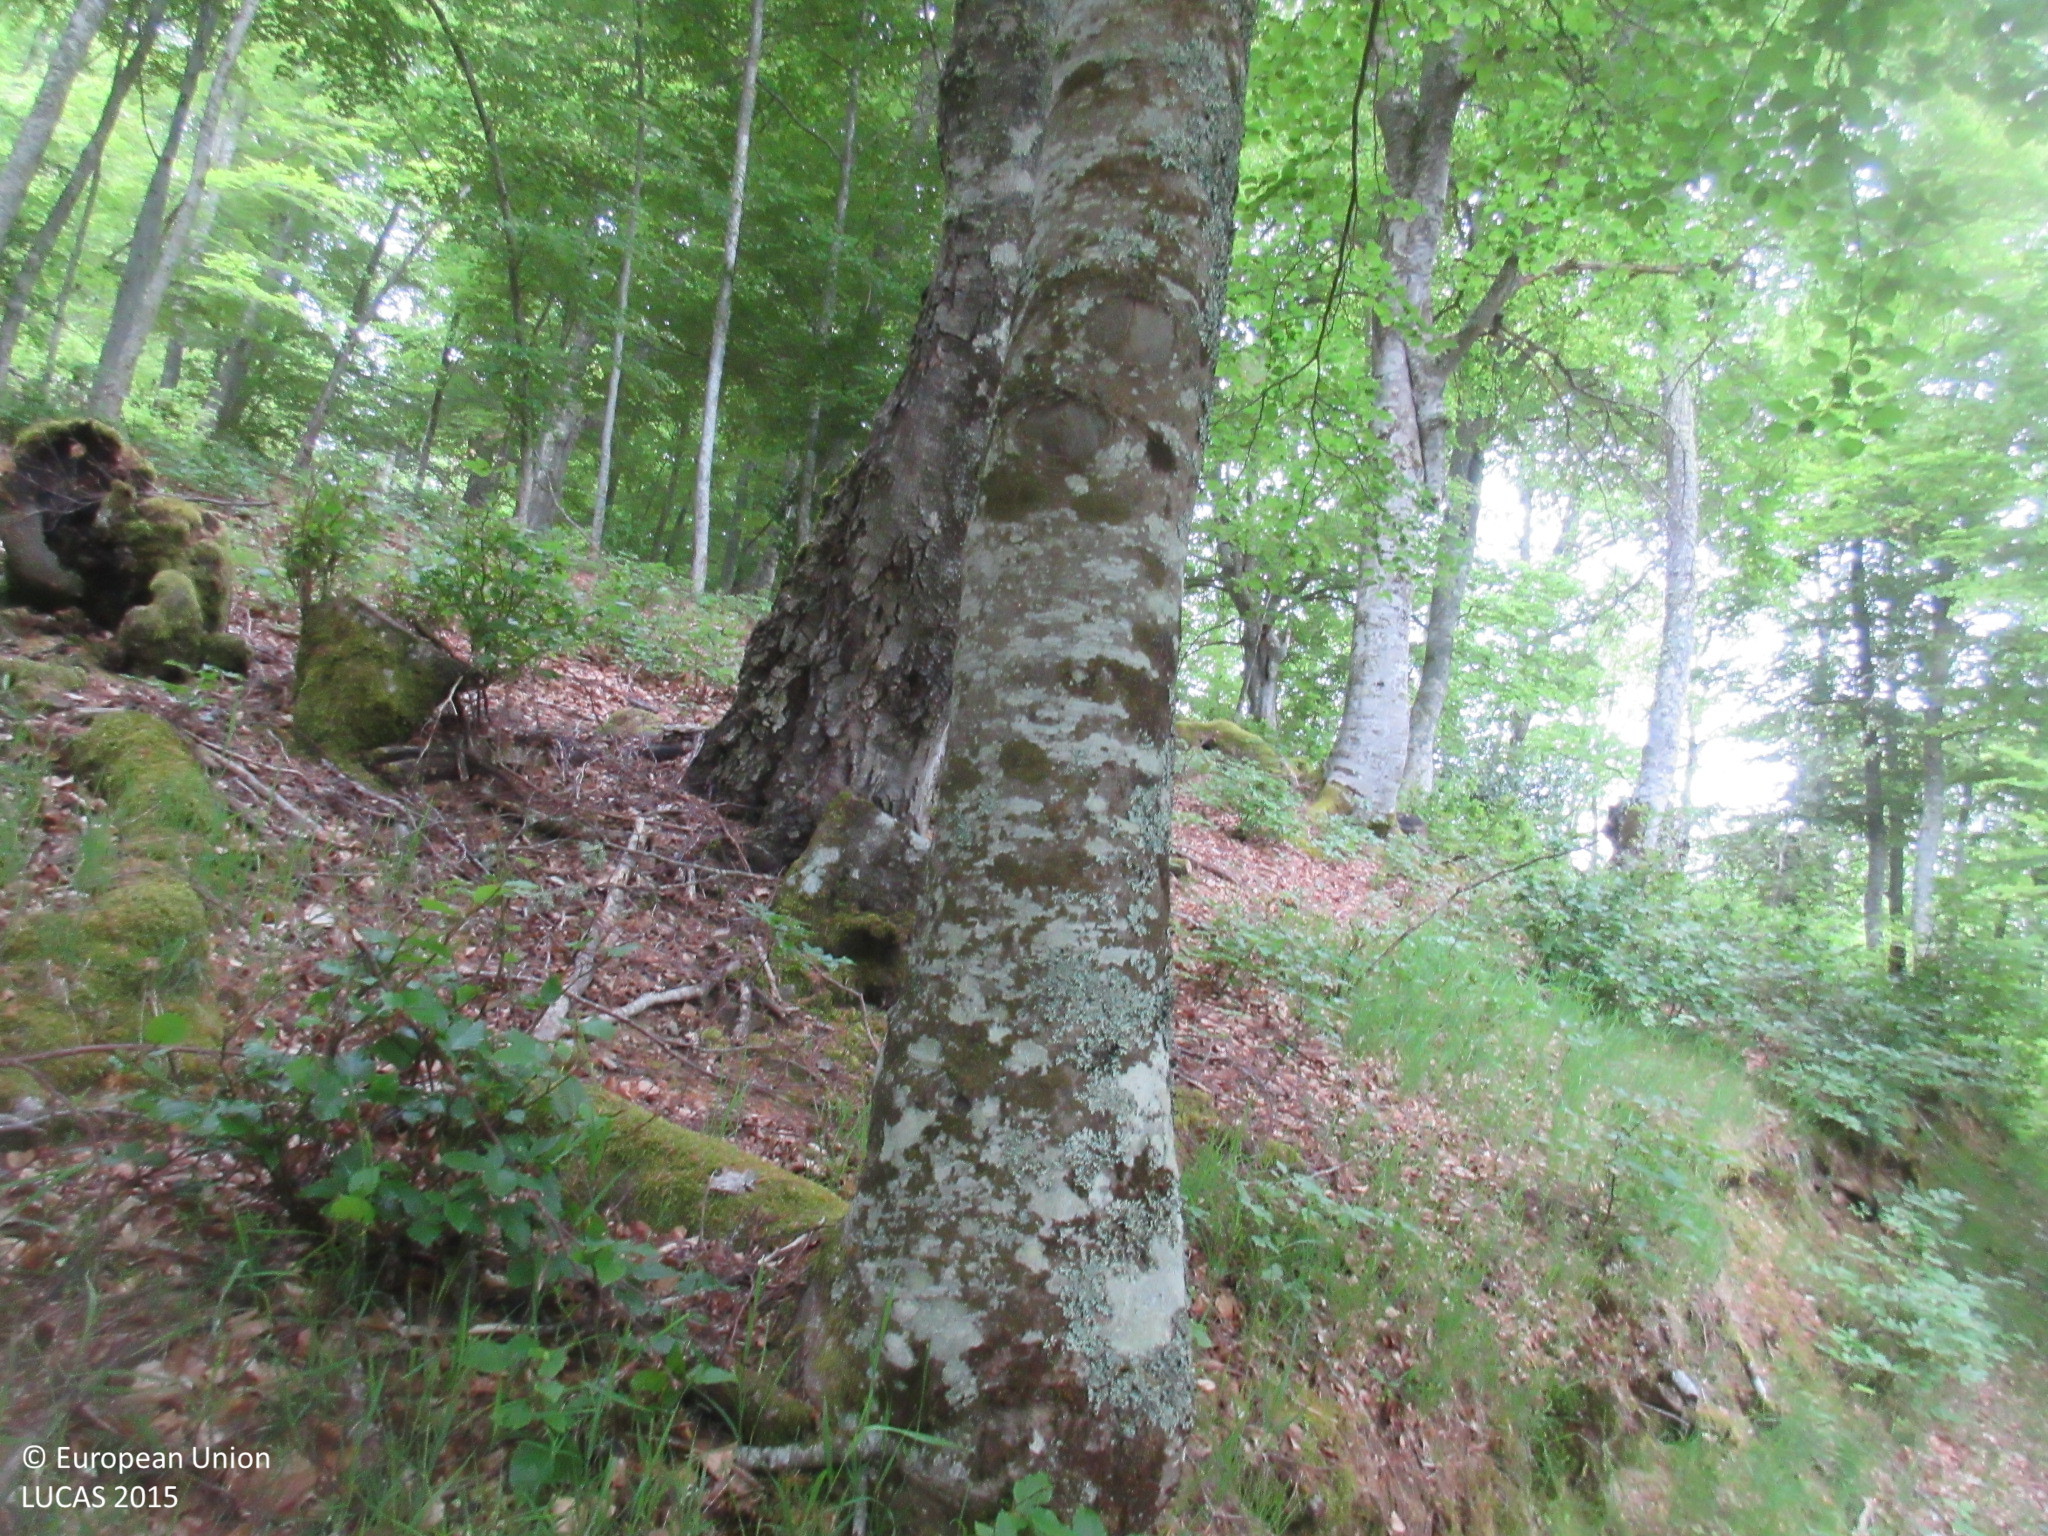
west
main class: Woodland
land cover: Broadleaved woodland
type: beech forest
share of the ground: > 75 %
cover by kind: broadleaved forest trees 95 %, shrubs 5 %
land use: Semi-natural and natural areas not in use
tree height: > 5 m
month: June
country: ES
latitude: 43.0713
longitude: -4.4871
